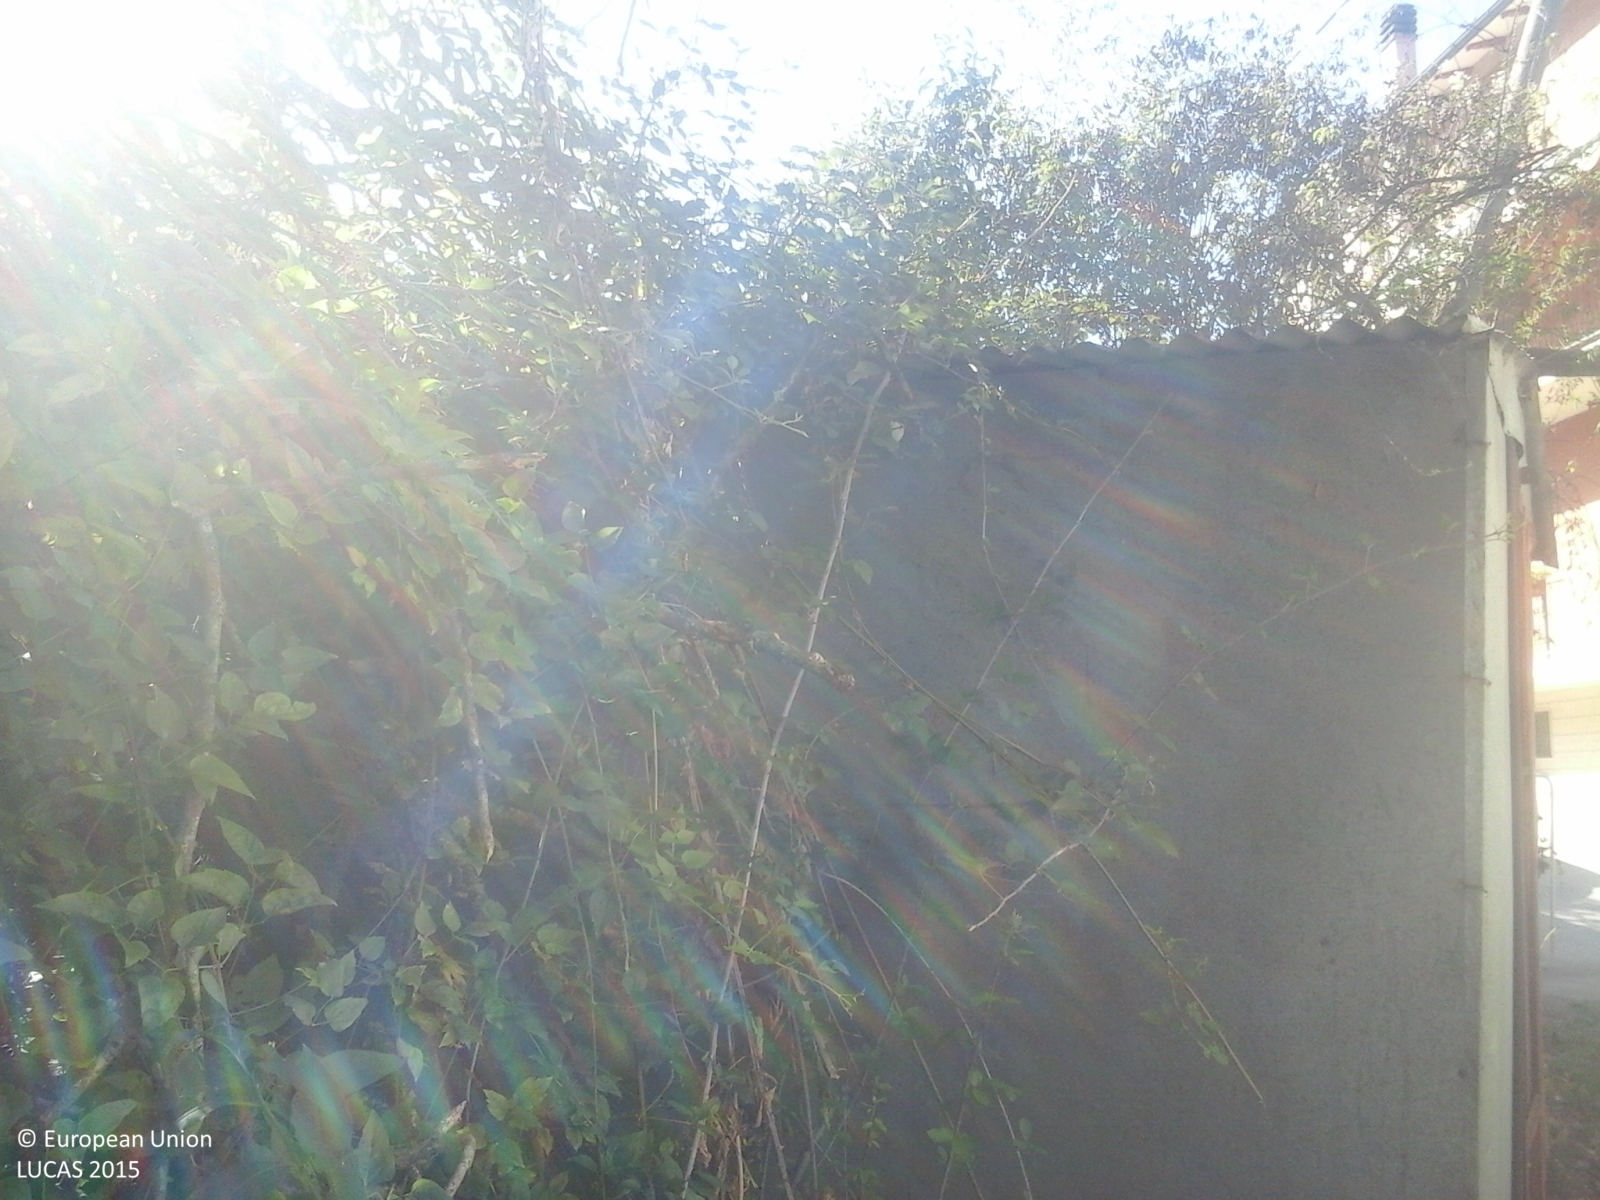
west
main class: Cropland
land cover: Other fruit trees and berries
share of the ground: 25 - 50 %
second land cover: Shrubland without tree cover
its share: > 75 %
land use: Abandoned areas
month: August
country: IT
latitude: 42.5139
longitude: 12.5355
